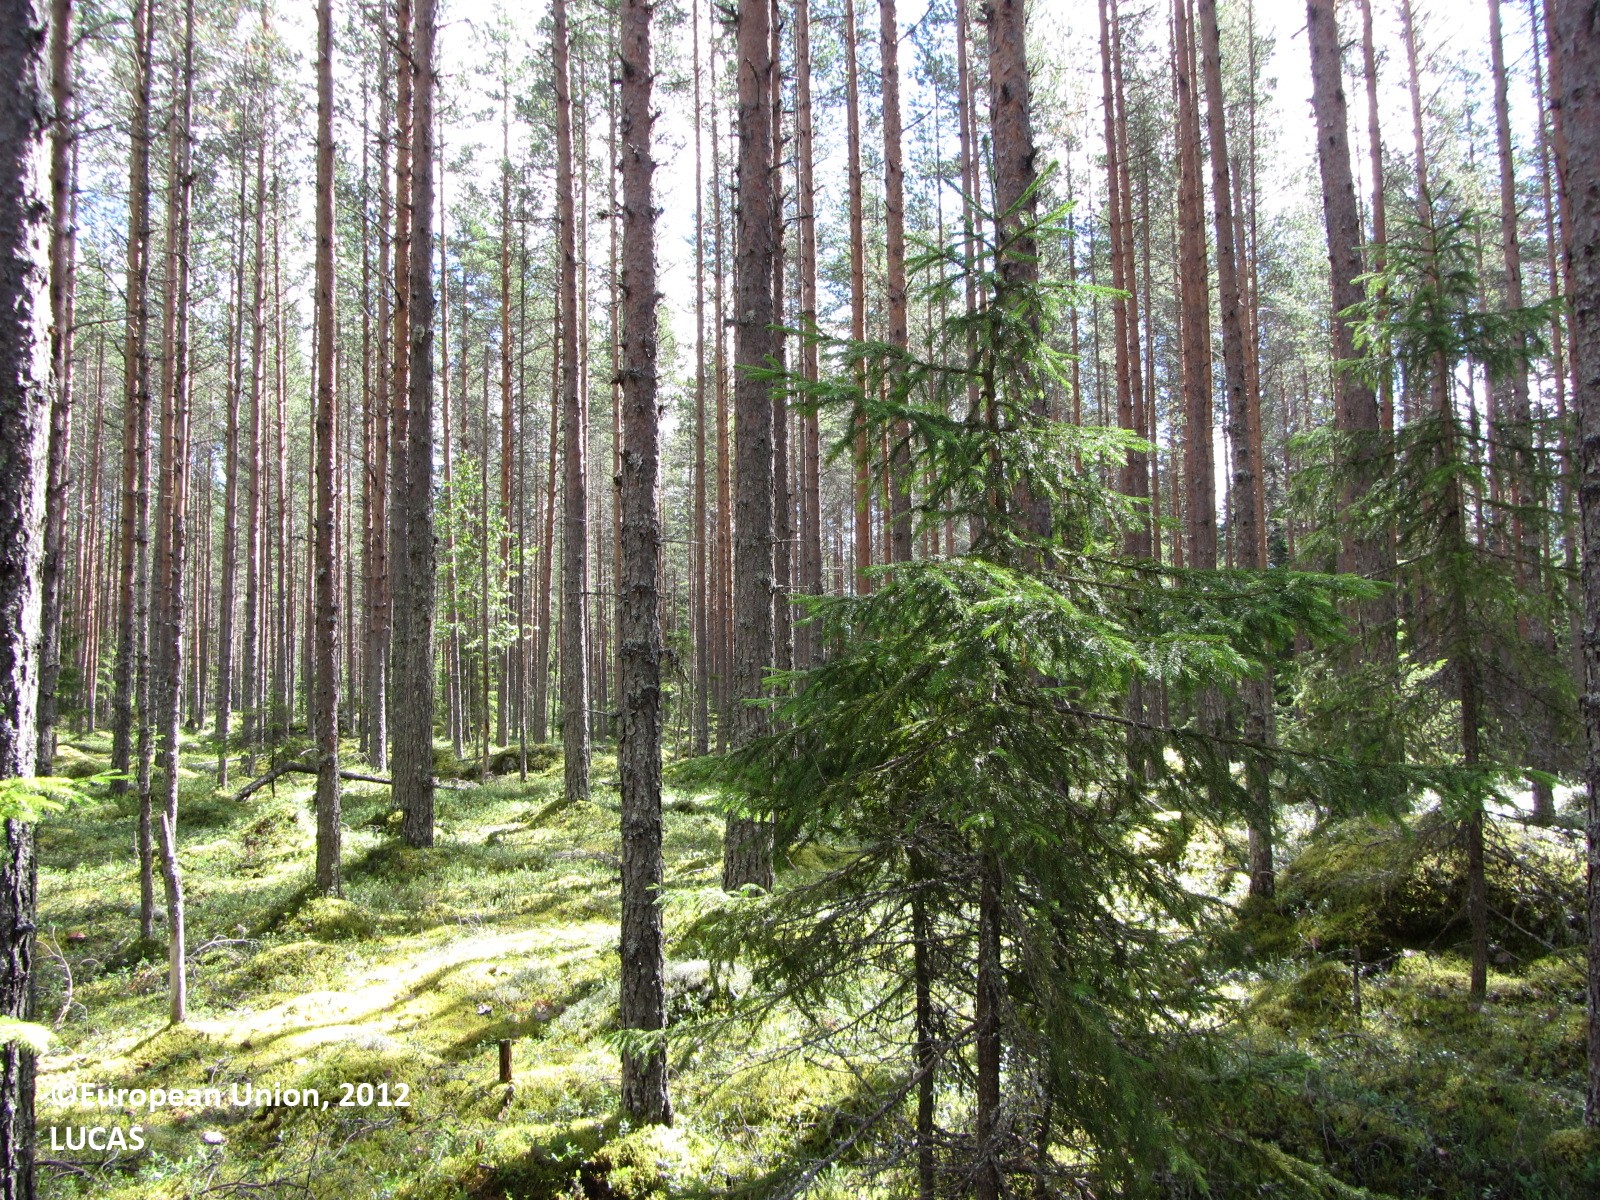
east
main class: Woodland
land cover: Pine dominated coniferous woodland
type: boreal forest
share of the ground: 50 - 75 %
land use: Forestry
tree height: > 5 m
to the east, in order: Pine dominated coniferous woodland; Rock outcrops; Pine dominated coniferous woodland; Shrubland with sparse tree cover; Pine dominated coniferous woodland; Shrubland with sparse tree cover; Pine dominated mixed woodland; Pine dominated coniferous woodland
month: July
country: FI
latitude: 63.6436
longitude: 25.5456
